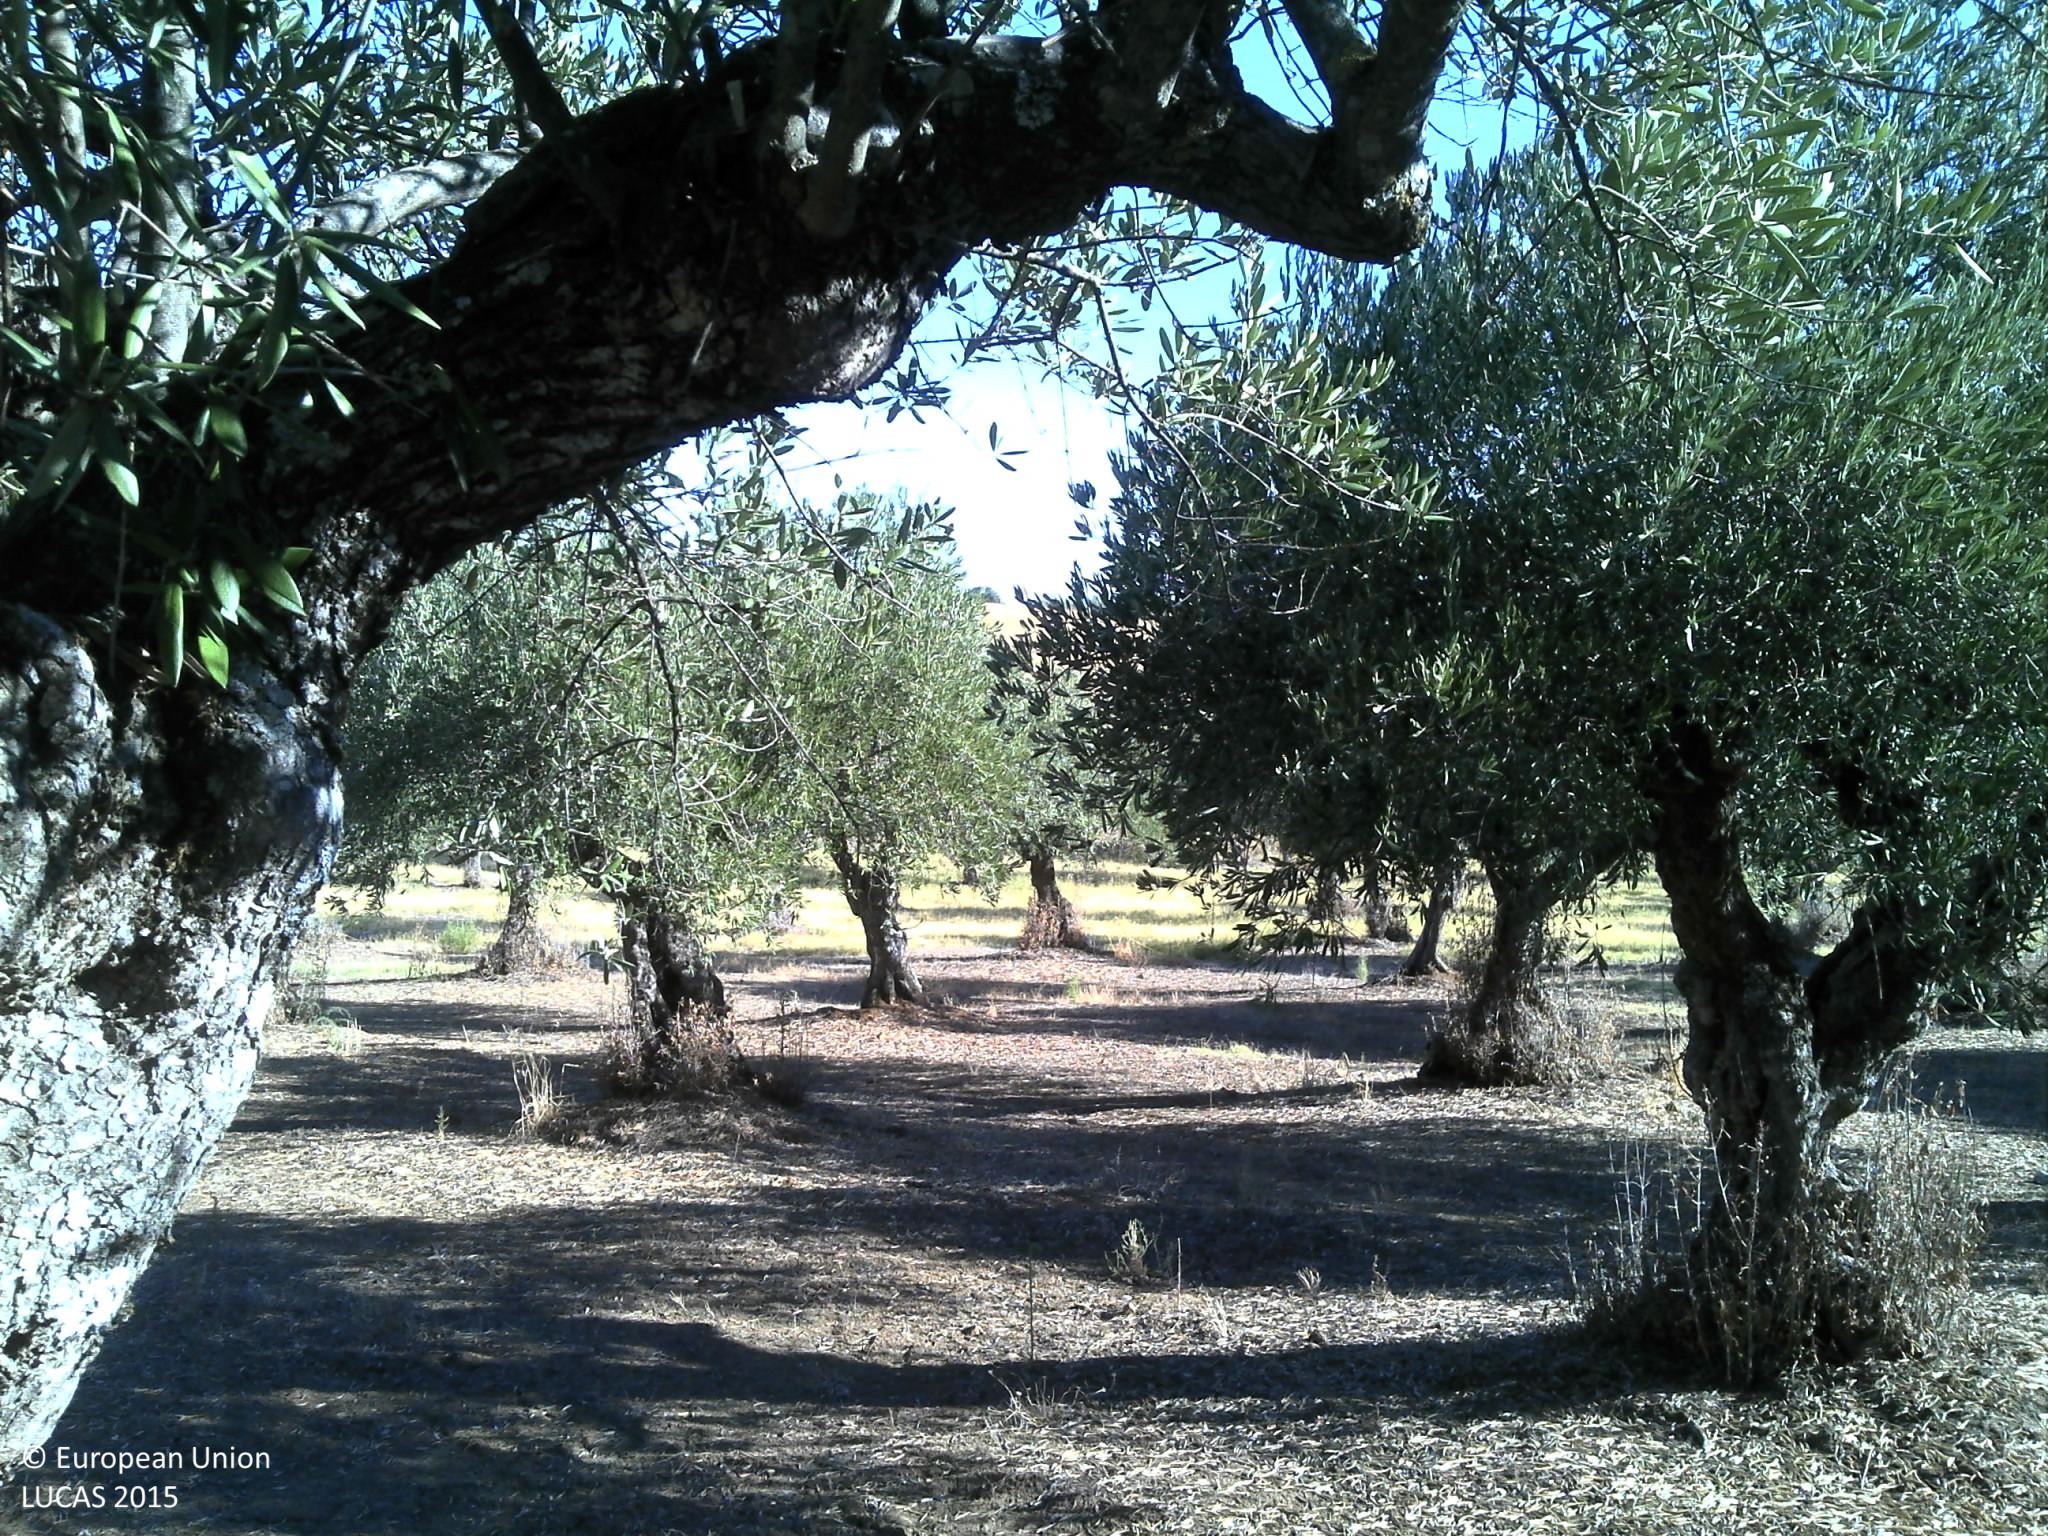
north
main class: Cropland
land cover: Olive groves
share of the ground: 25 - 50 %
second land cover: Grassland without tree/shrub cover
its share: < 10 %
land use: Agriculture (excluding fallow land and kitchen gardens)
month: July
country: PT
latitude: 39.0262
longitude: -7.0188
